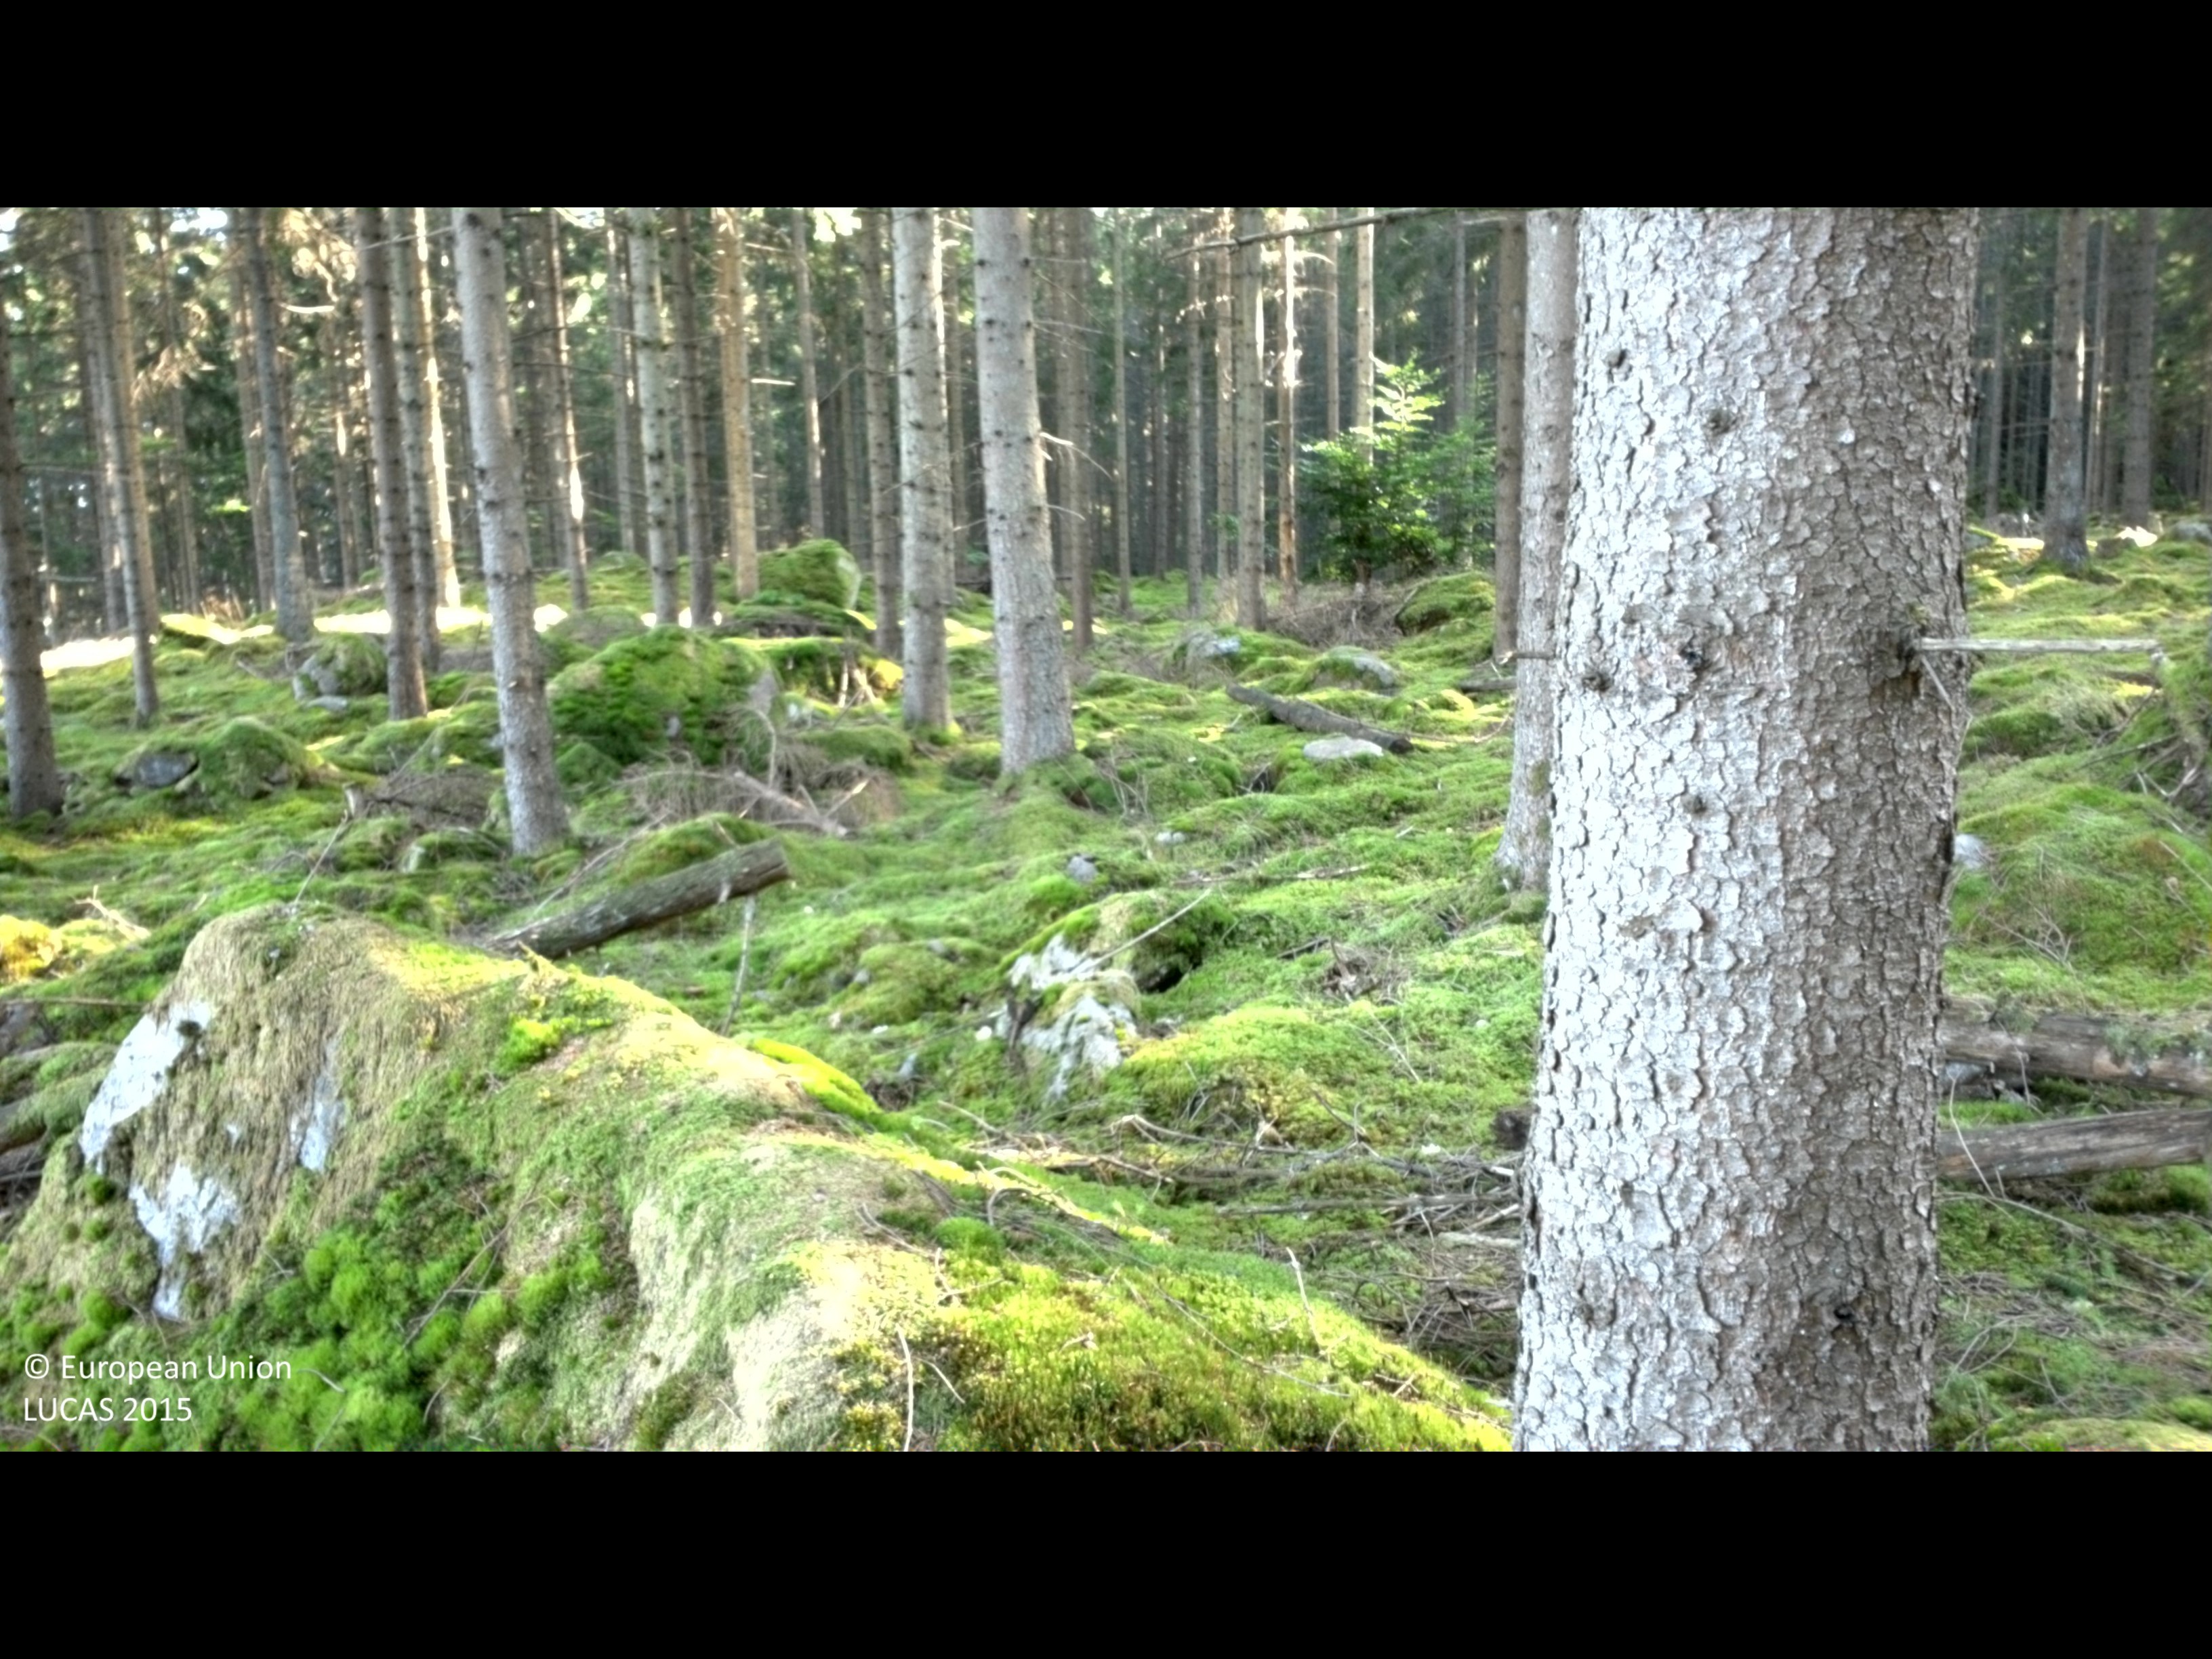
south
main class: Woodland
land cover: Spruce dominated coniferous woodland
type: boreal forest
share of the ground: 50 - 75 %
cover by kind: coniferous forest trees 70 %, lichens and mosses 30 %
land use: Forestry
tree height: > 5 m
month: August
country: SE
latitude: 56.3258
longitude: 14.4772
